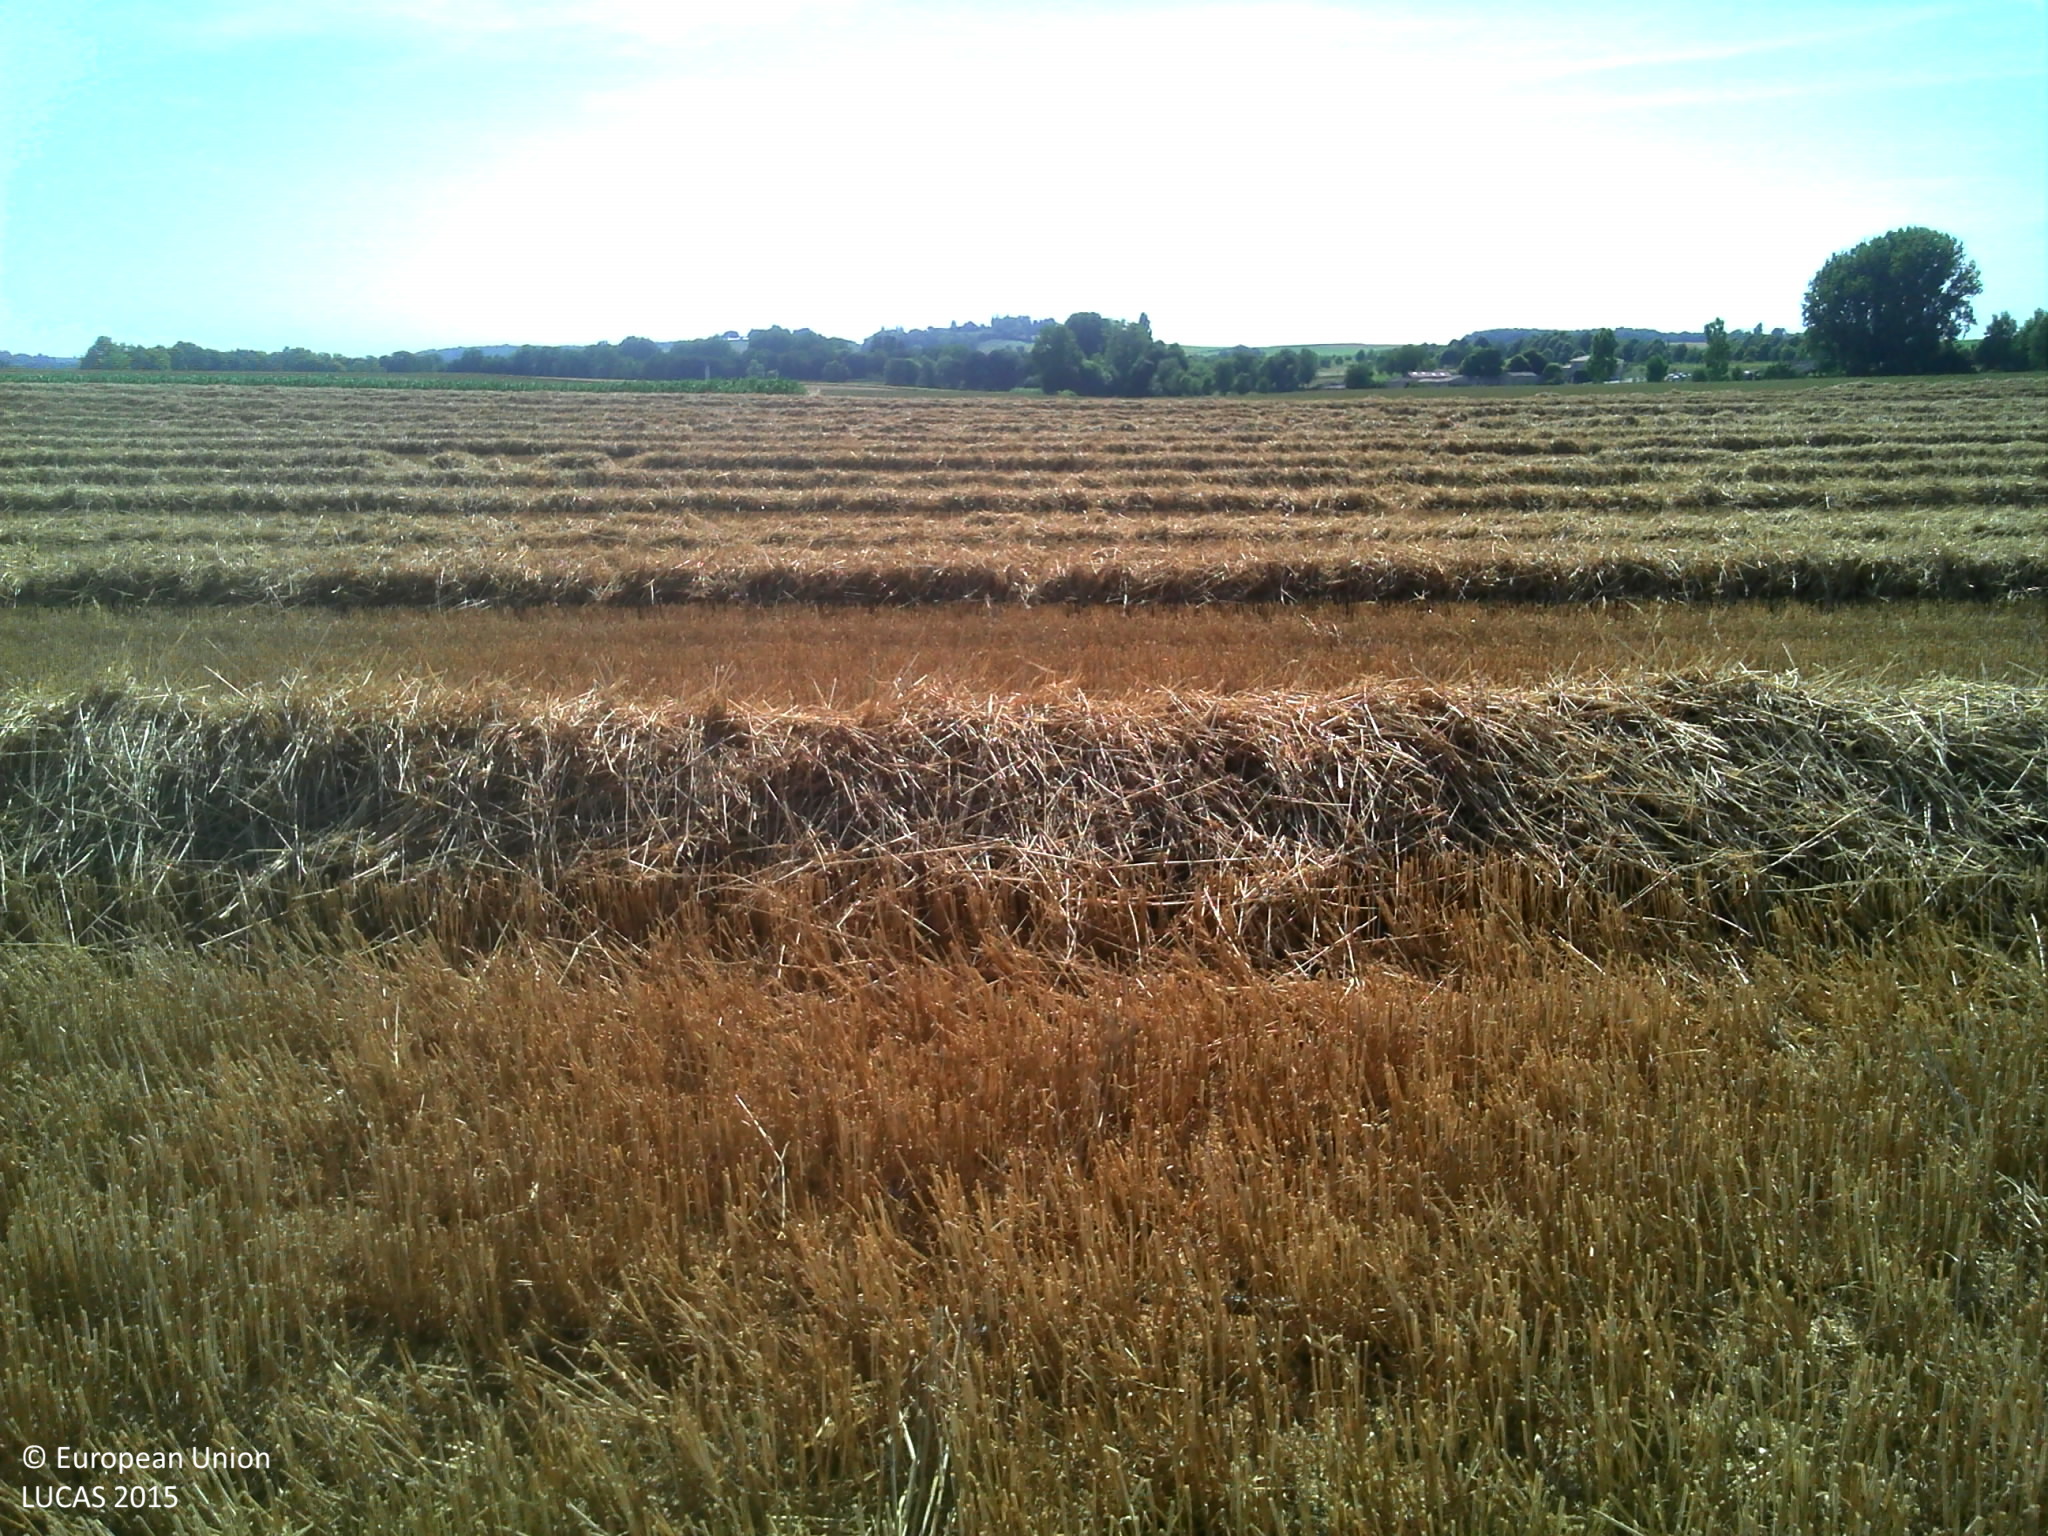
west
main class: Cropland
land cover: Common wheat
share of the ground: > 75 %
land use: Agriculture (excluding fallow land and kitchen gardens)
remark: Harvested field
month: July
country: FR
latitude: 45.3708
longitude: -0.5812
